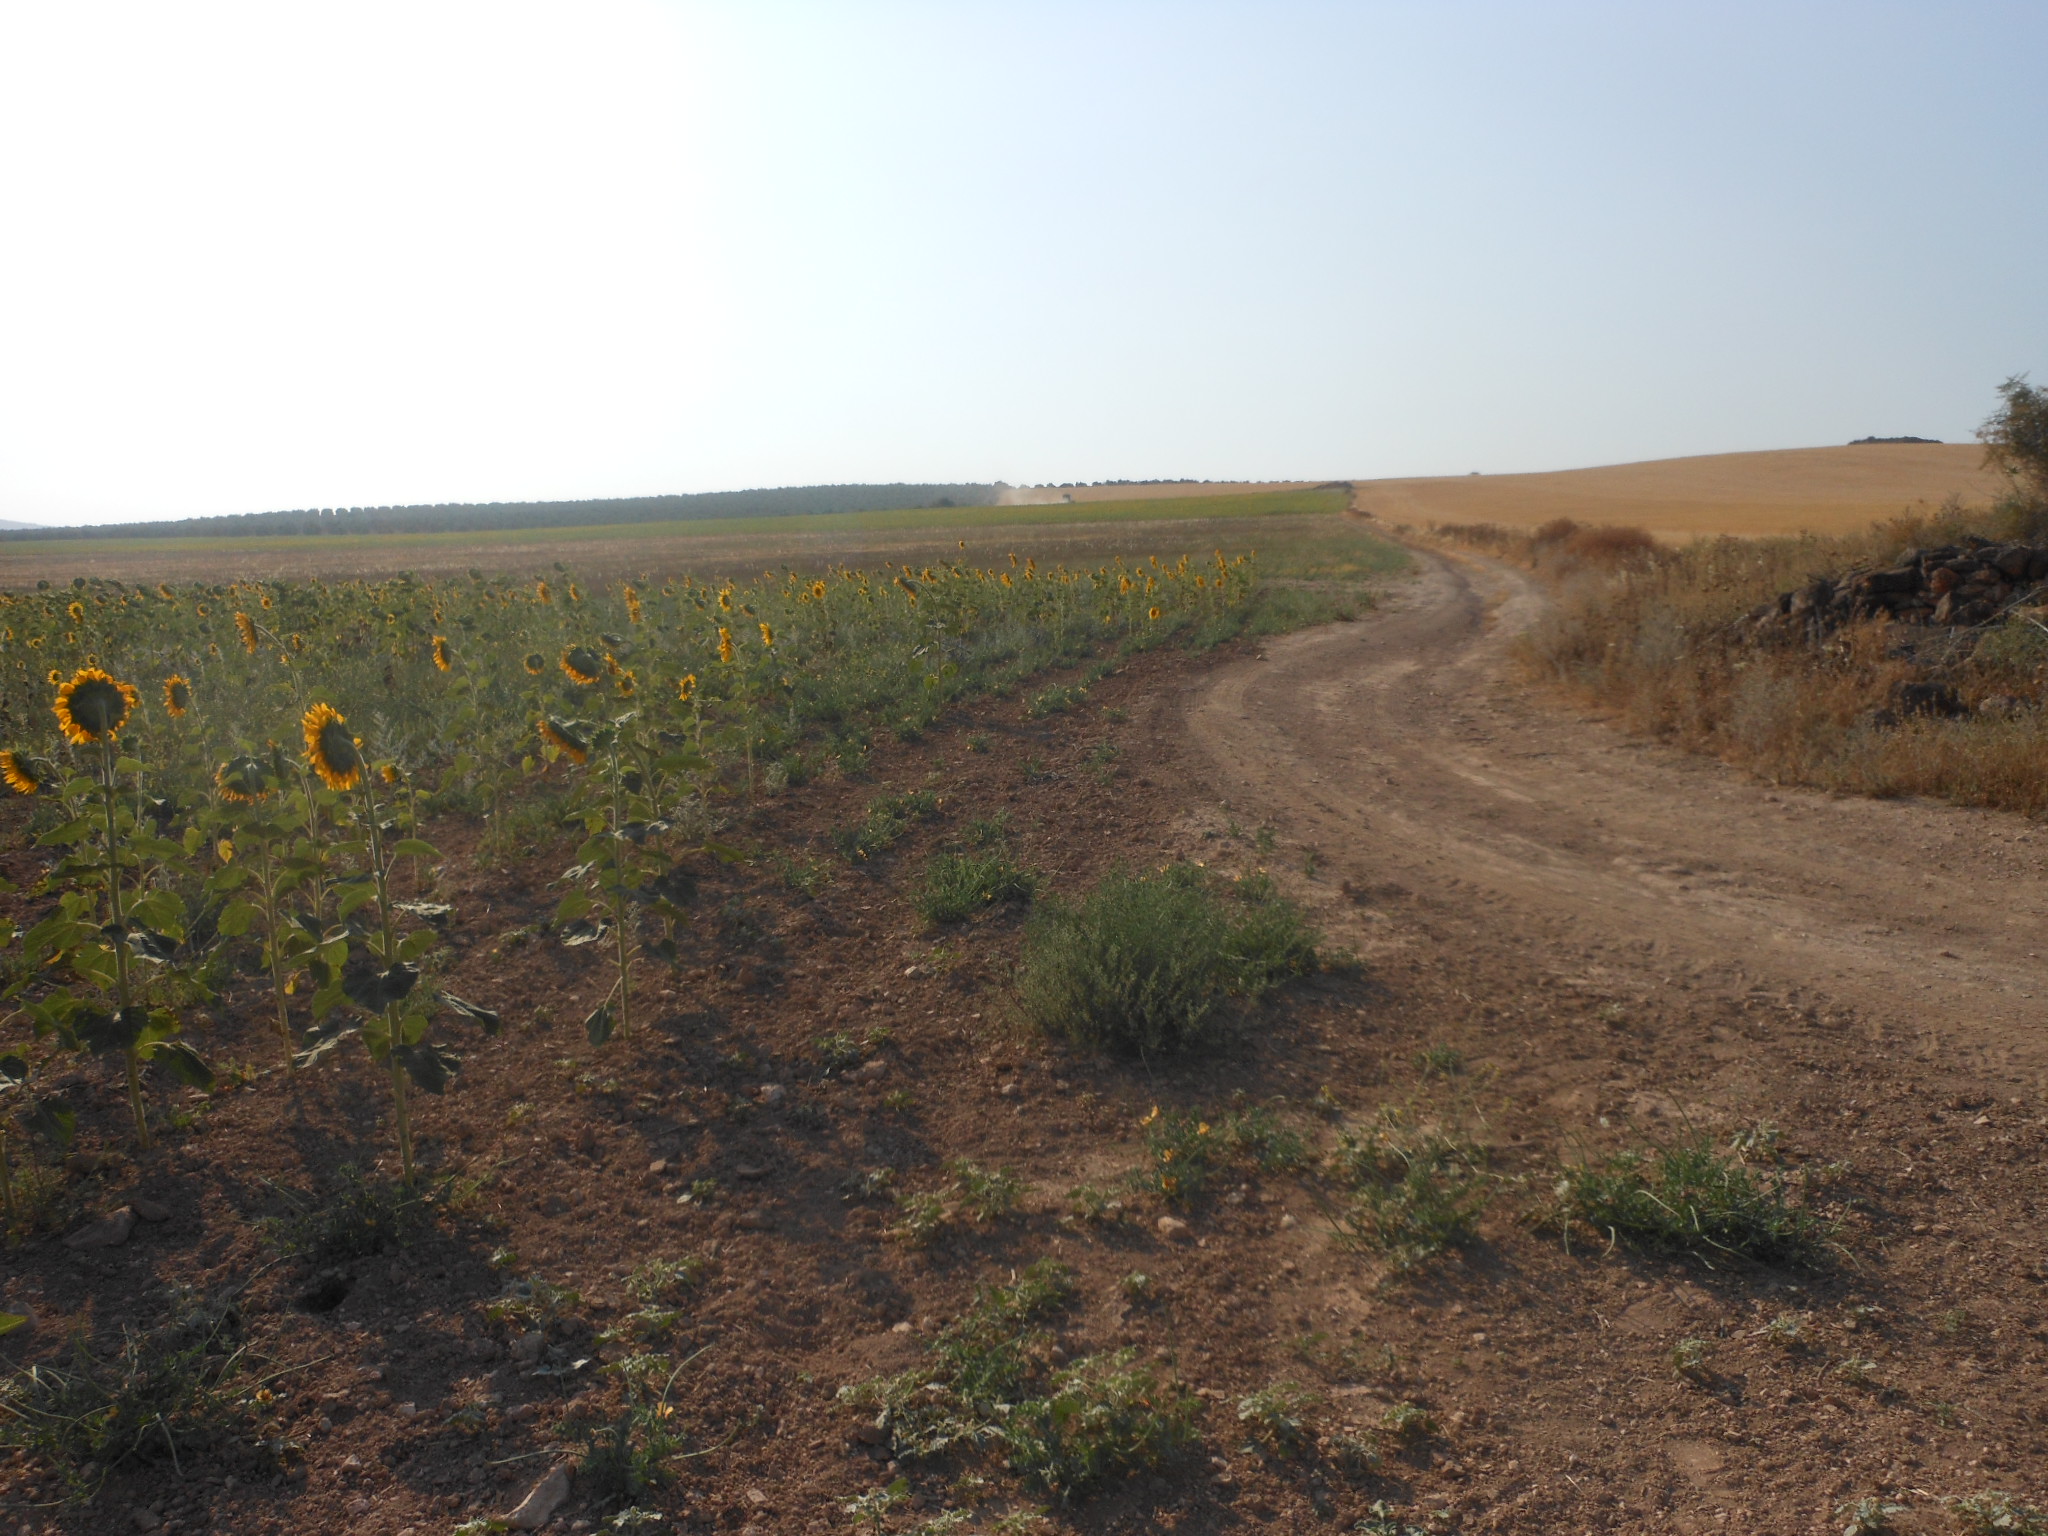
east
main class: Cropland
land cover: Sunflower
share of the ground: 25 - 50 %
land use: Agriculture (excluding fallow land and kitchen gardens)
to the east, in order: Sunflower; Grass margins; Dry pulses
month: June
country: ES
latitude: 37.2942
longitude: -5.0677
